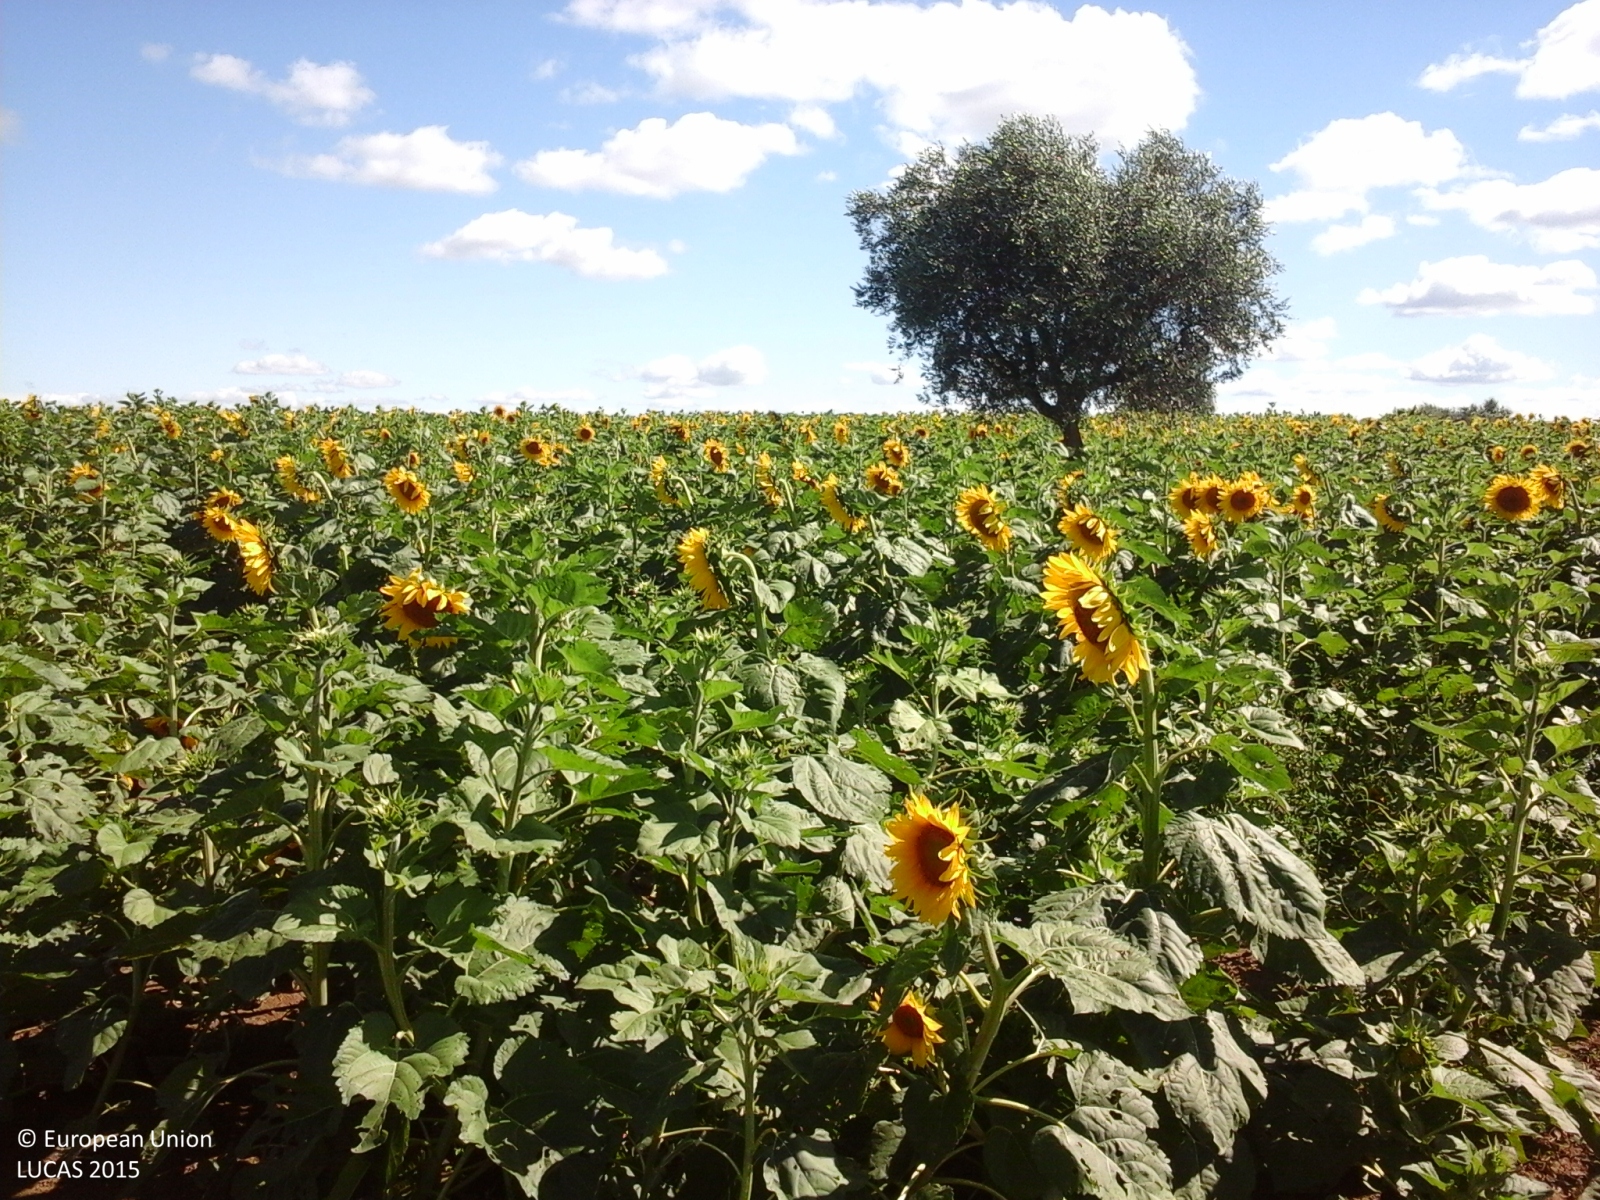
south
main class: Cropland
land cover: Sunflower
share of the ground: > 75 %
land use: Agriculture (excluding fallow land and kitchen gardens)
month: June
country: IT
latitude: 43.2982
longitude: 13.5041
